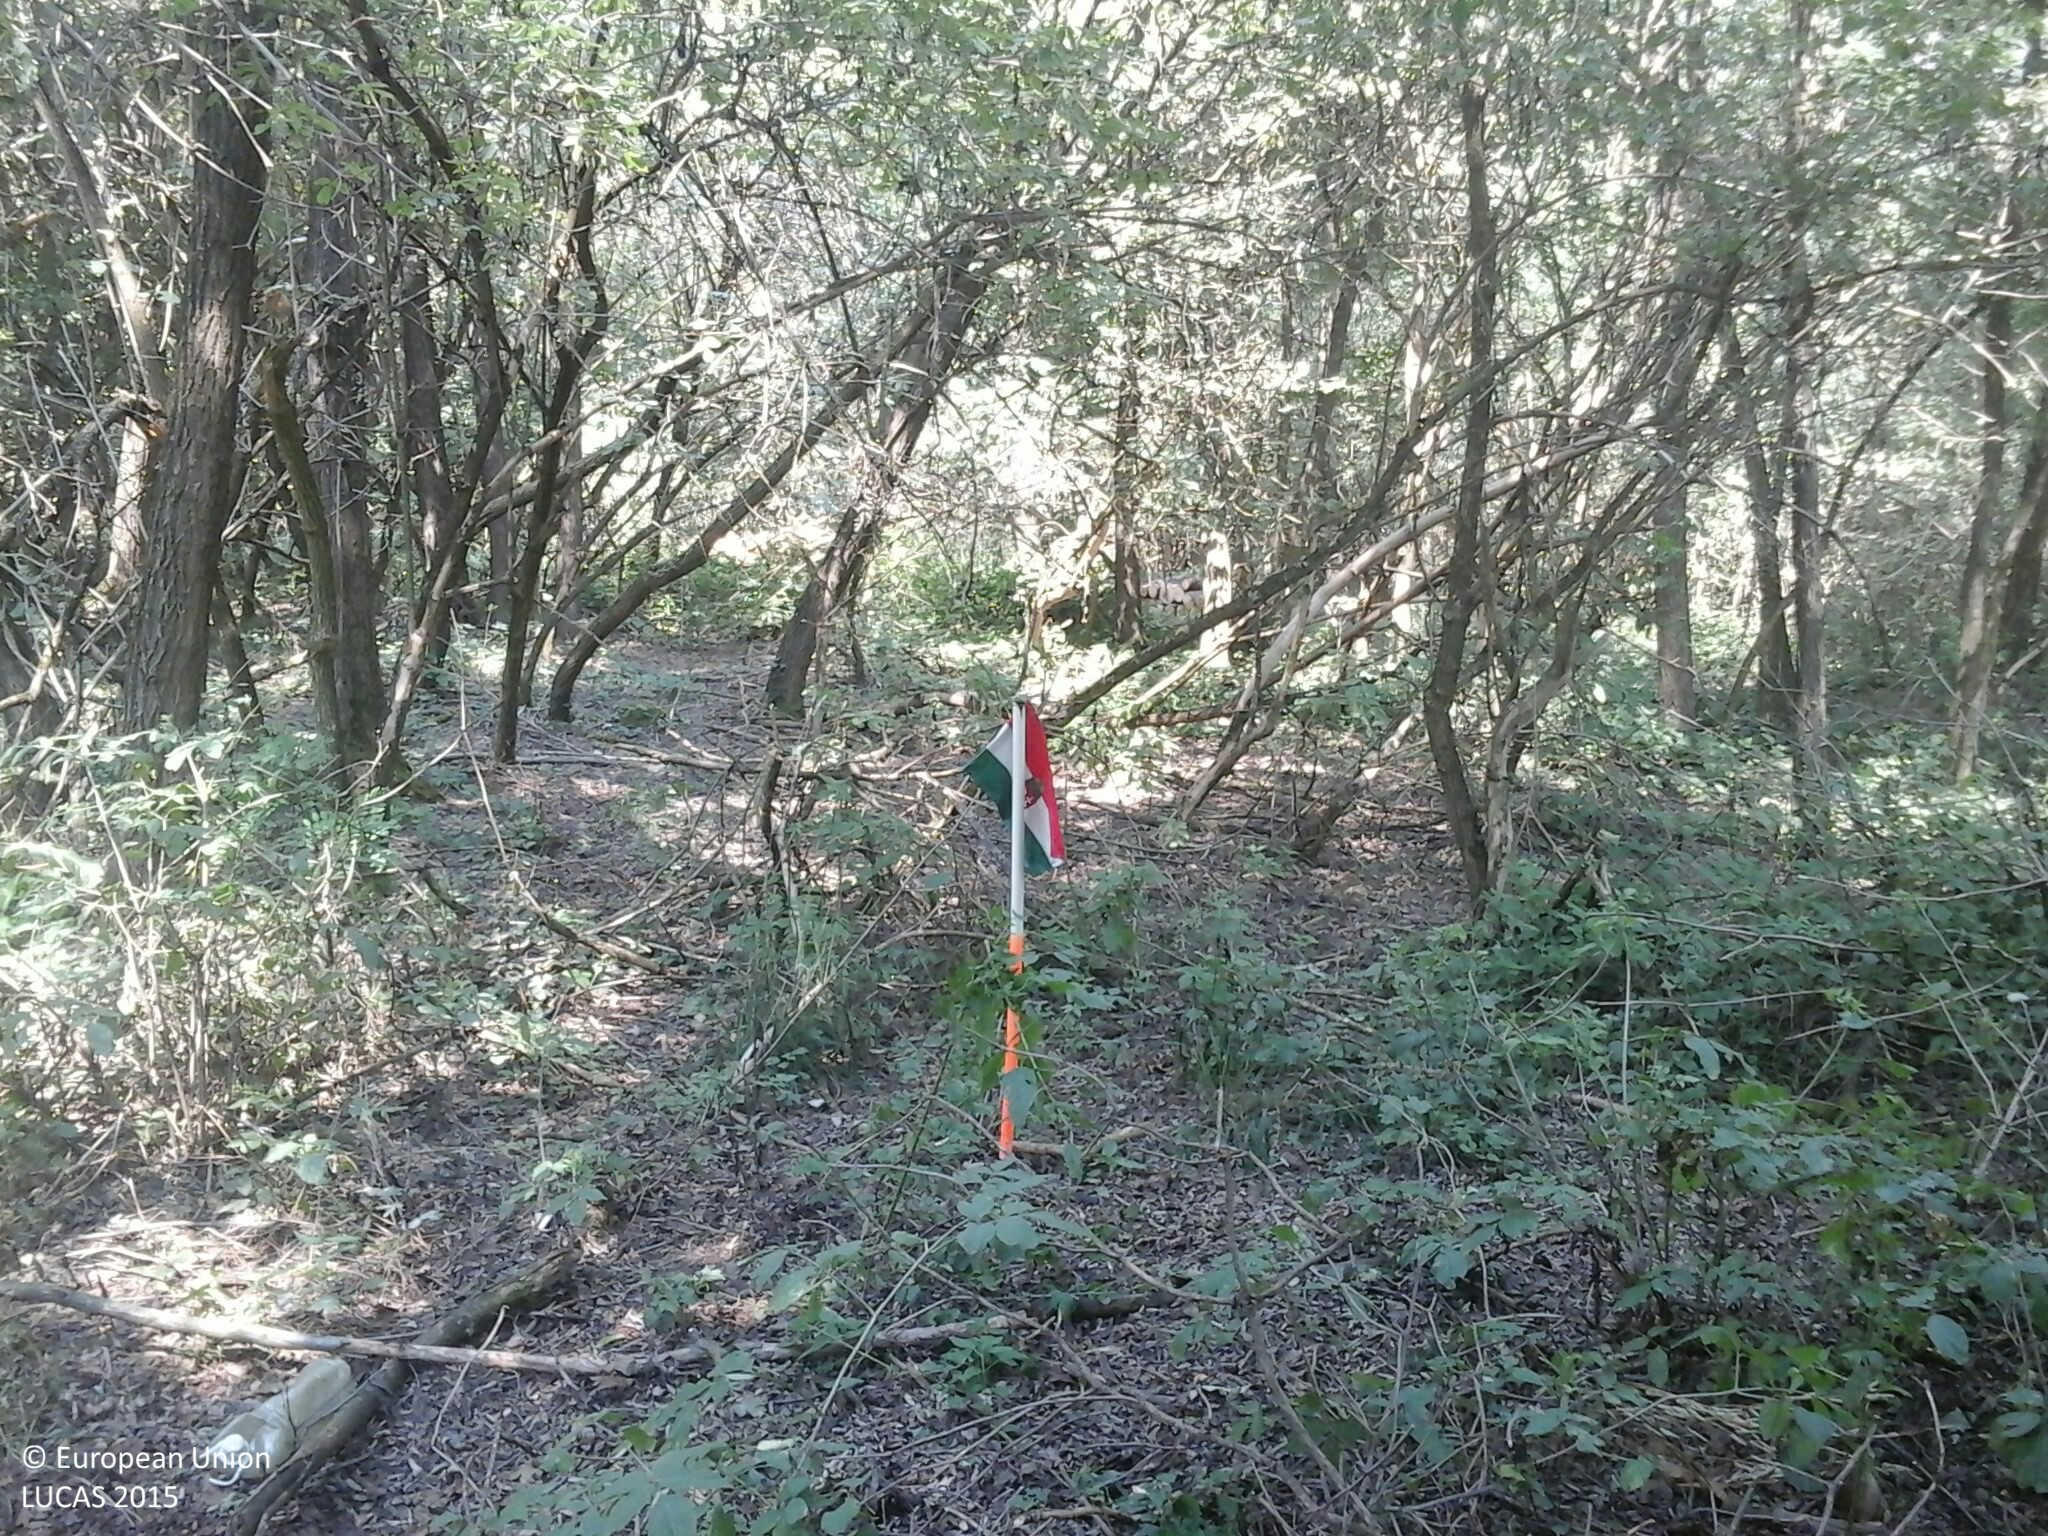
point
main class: Woodland
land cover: Broadleaved woodland
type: mesophytic deciduous forest
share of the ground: > 75 %
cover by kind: broadleaved forest trees 100 %
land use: Forestry
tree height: > 5 m
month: August
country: HU
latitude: 46.1722
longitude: 18.0762
